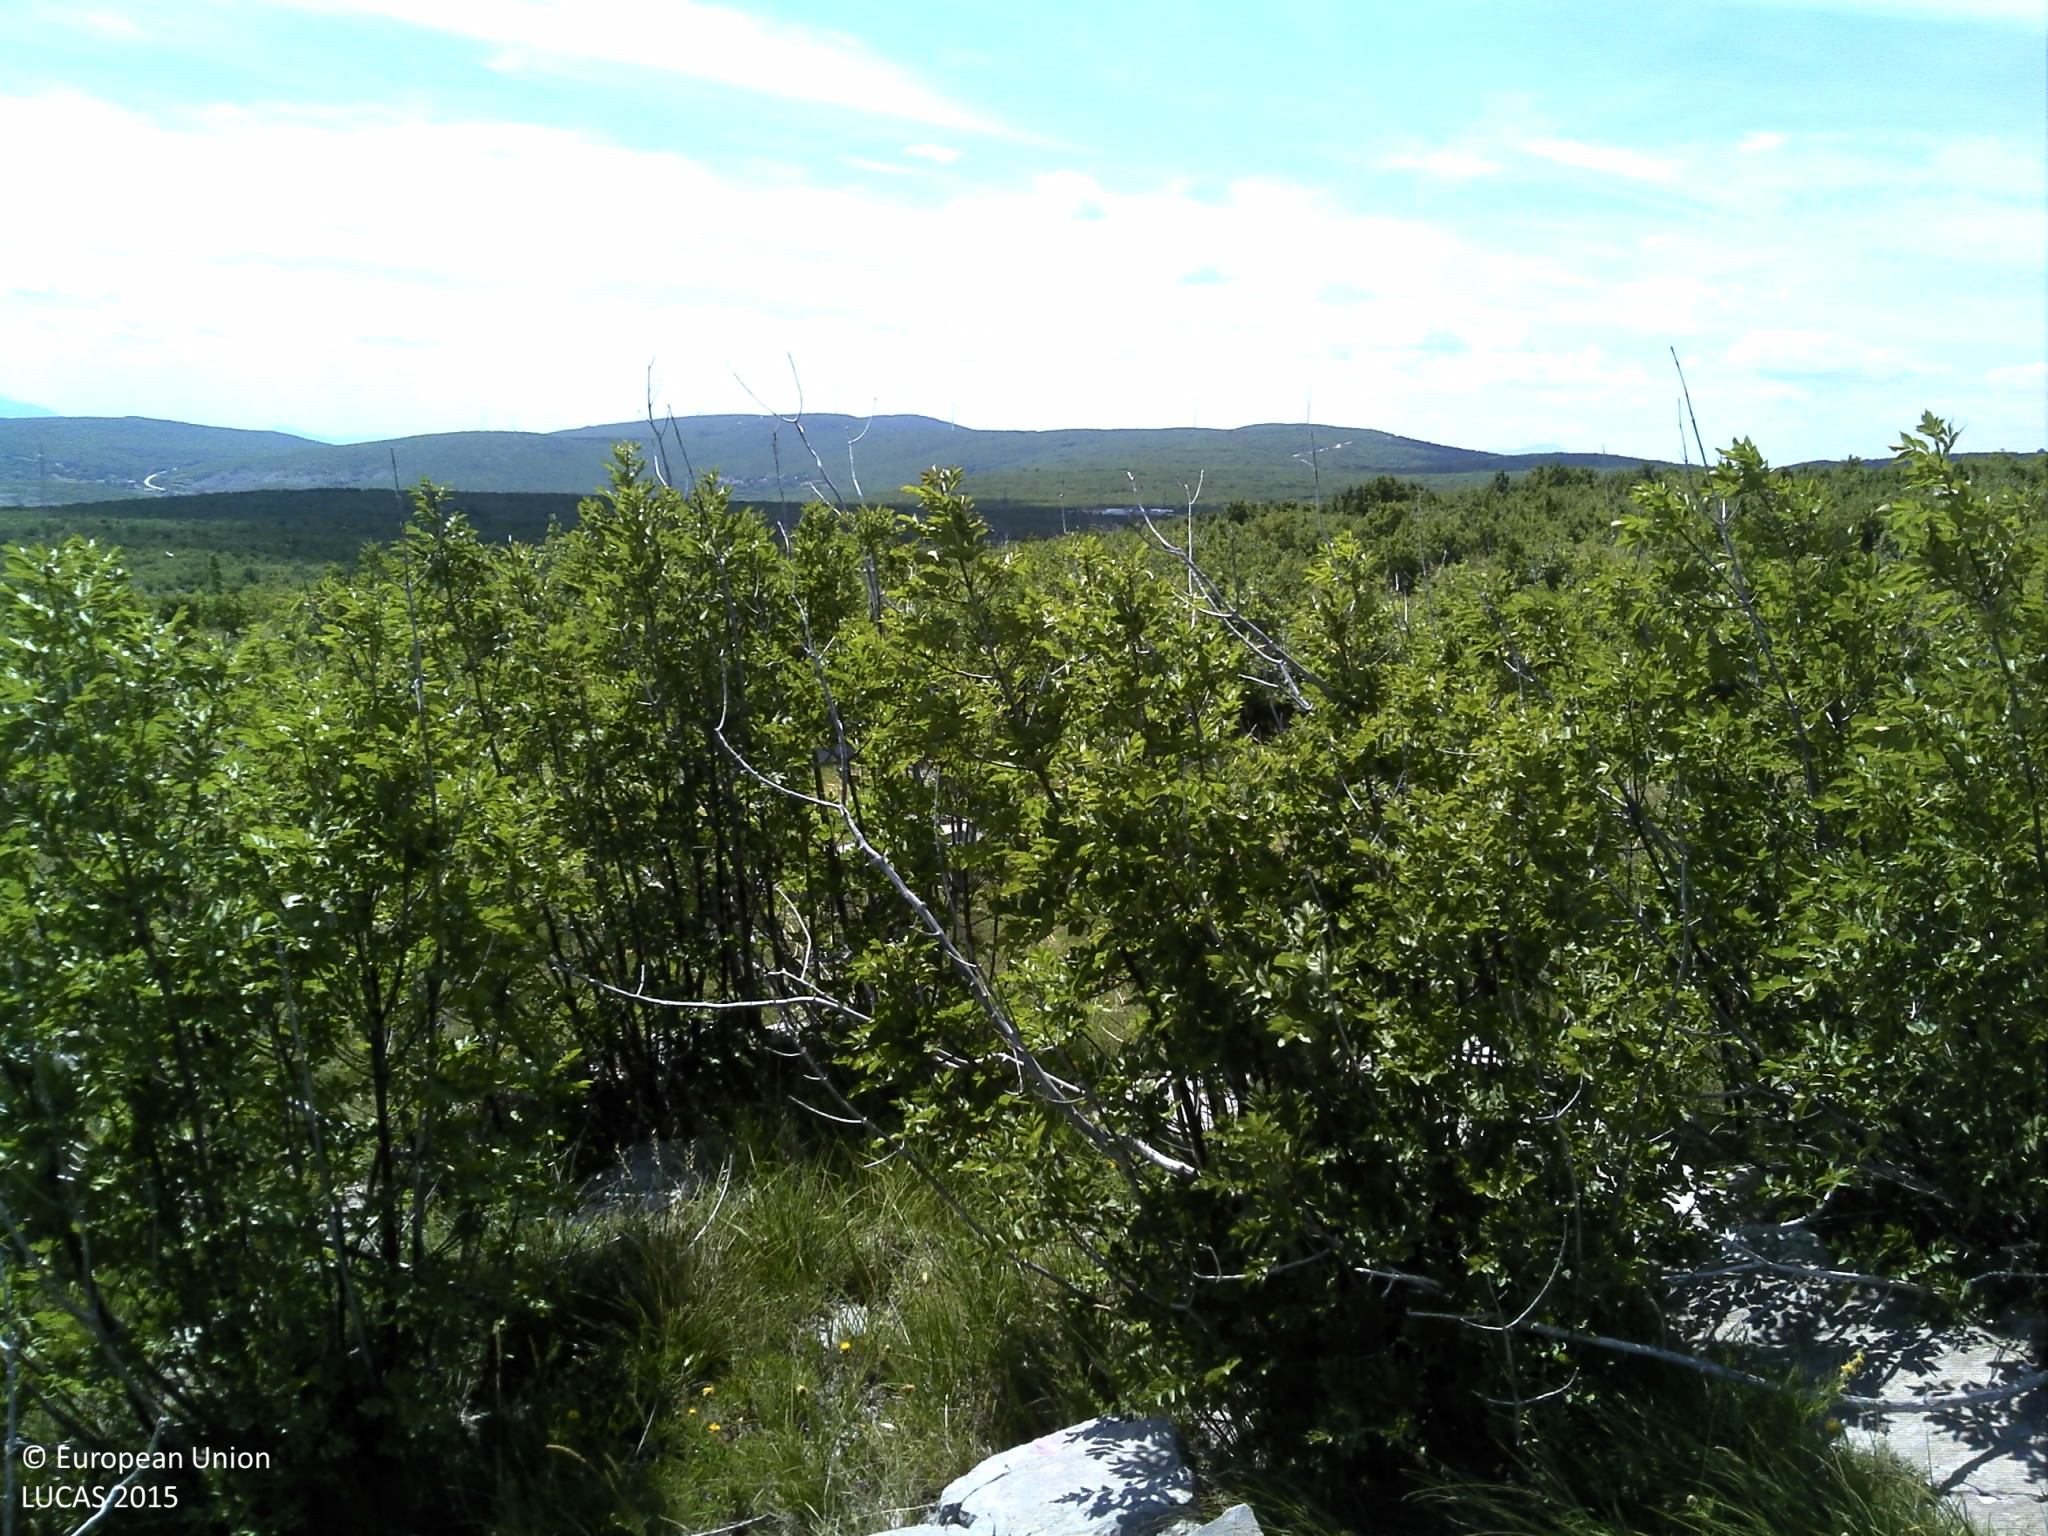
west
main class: Shrubland
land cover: Shrubland with sparse tree cover
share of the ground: > 75 %
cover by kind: shrubs 65 %, herbaceous plants 10 %, consolidated bare surface 10 %, unconsolidated bare surface 10 %, broadleaved forest trees 5 %
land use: Semi-natural and natural areas not in use
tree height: < 5 m
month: June
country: HR
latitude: 43.6127
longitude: 16.9184
